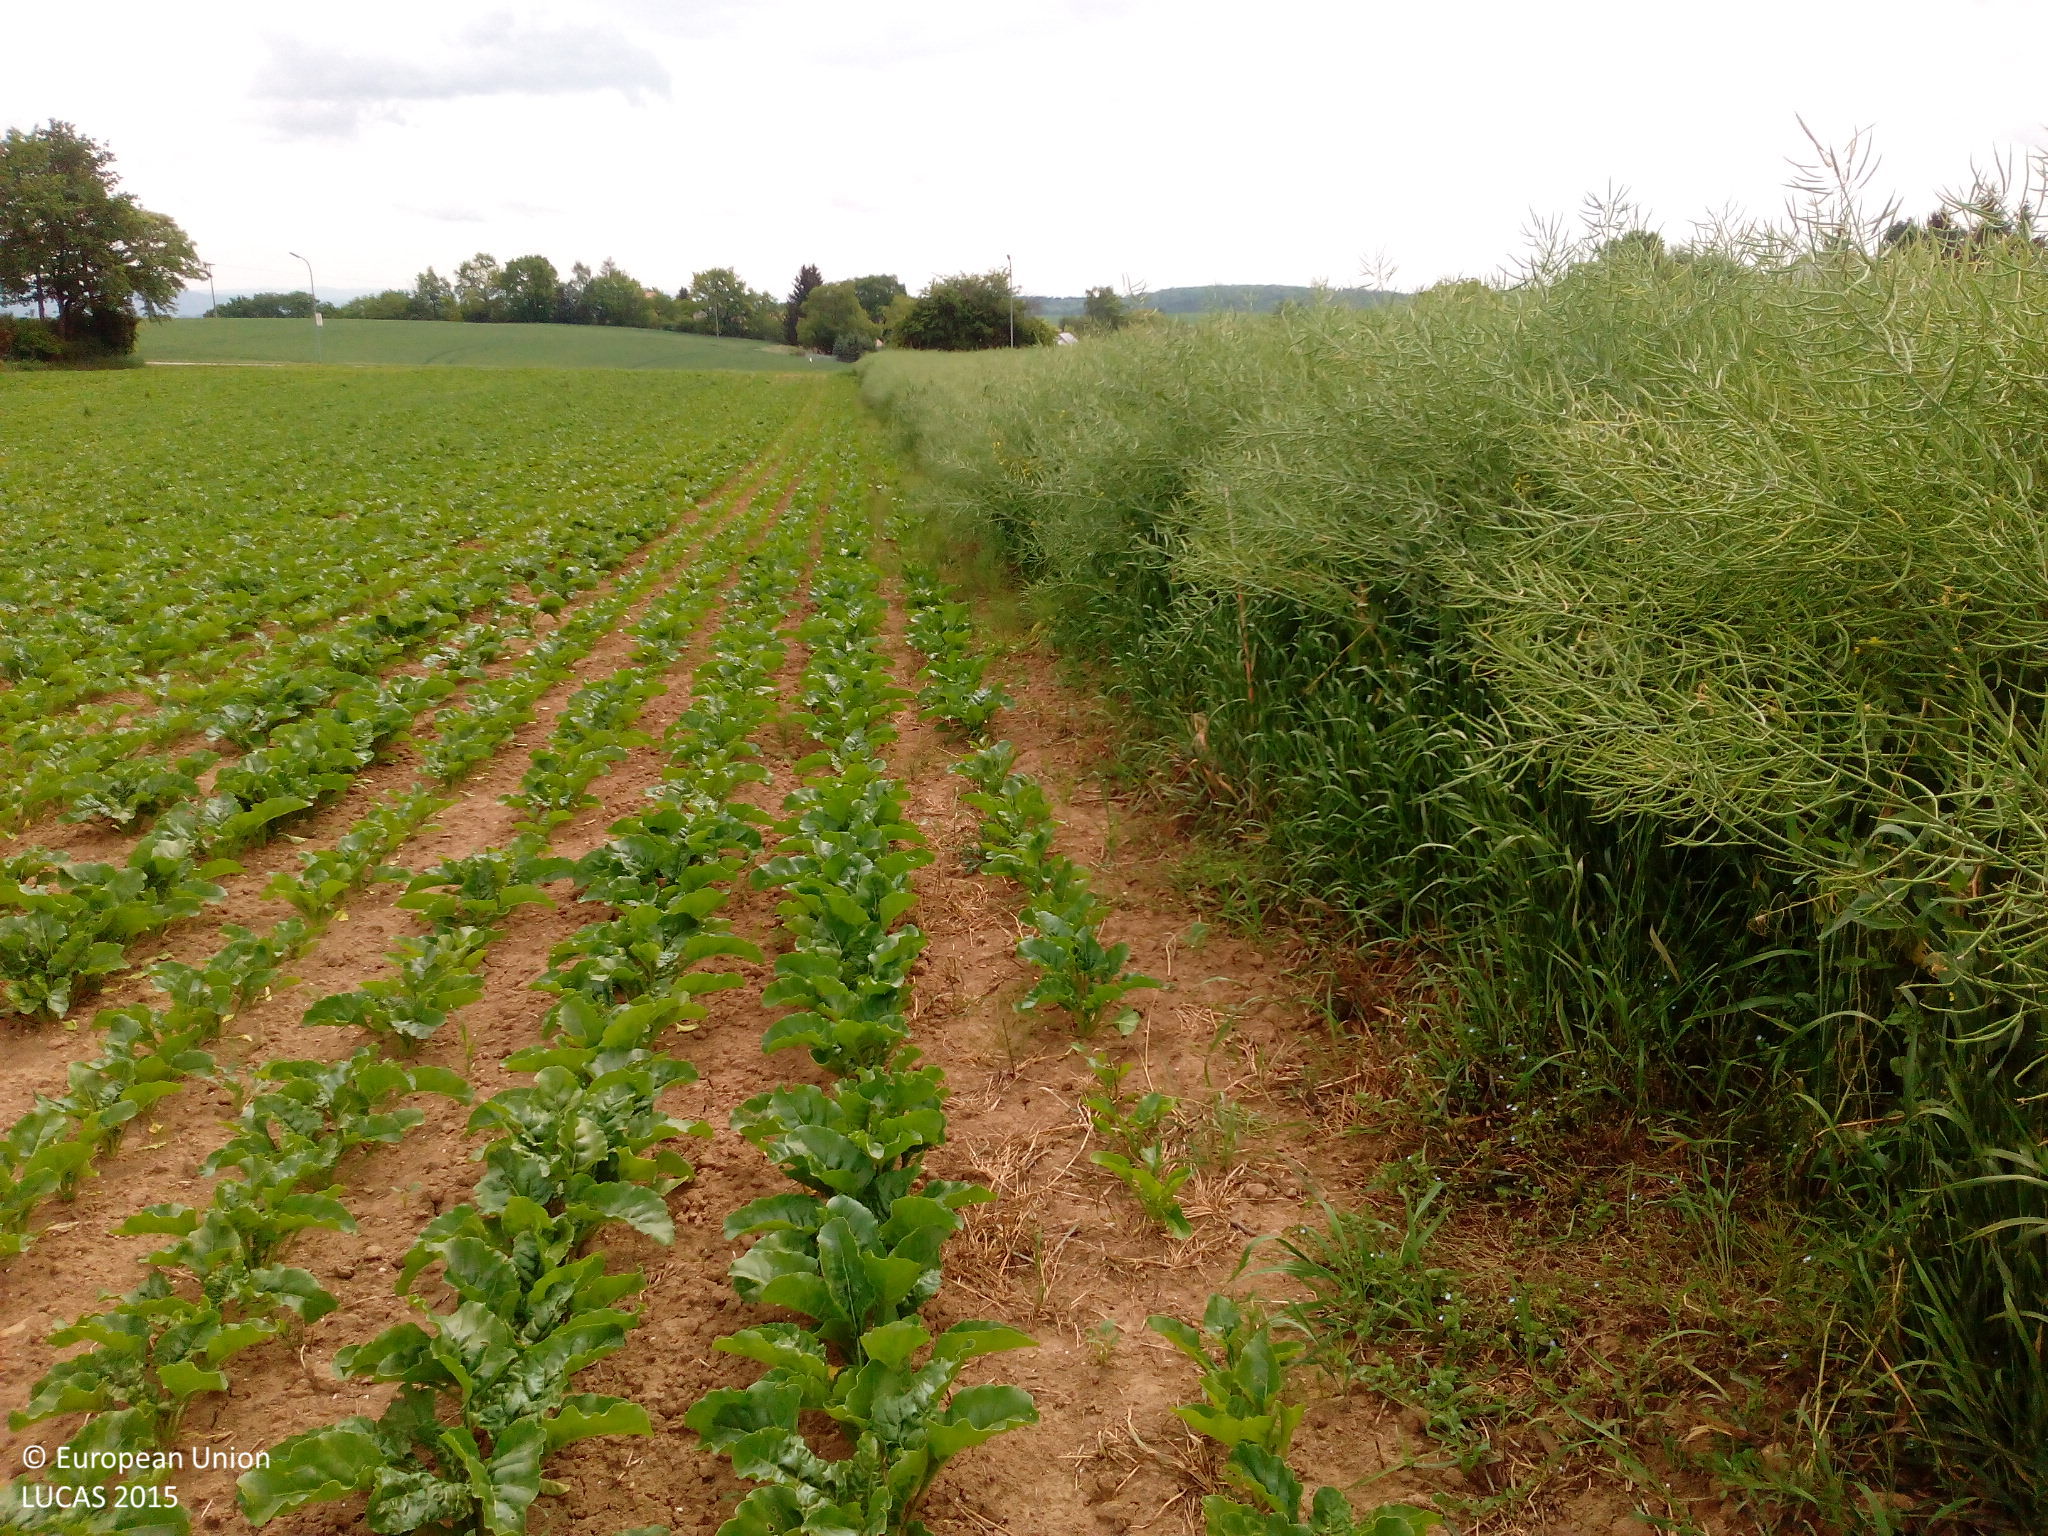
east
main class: Cropland
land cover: Rape and turnip rape
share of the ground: > 75 %
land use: Agriculture (excluding fallow land and kitchen gardens)
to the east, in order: Rape and turnip rape; Grass margins; Paved roads, cycling and walking lanes; Grass margins; Common wheat; Grassland without tree/shrub cover
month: June
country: DE
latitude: 48.9777
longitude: 12.0898
